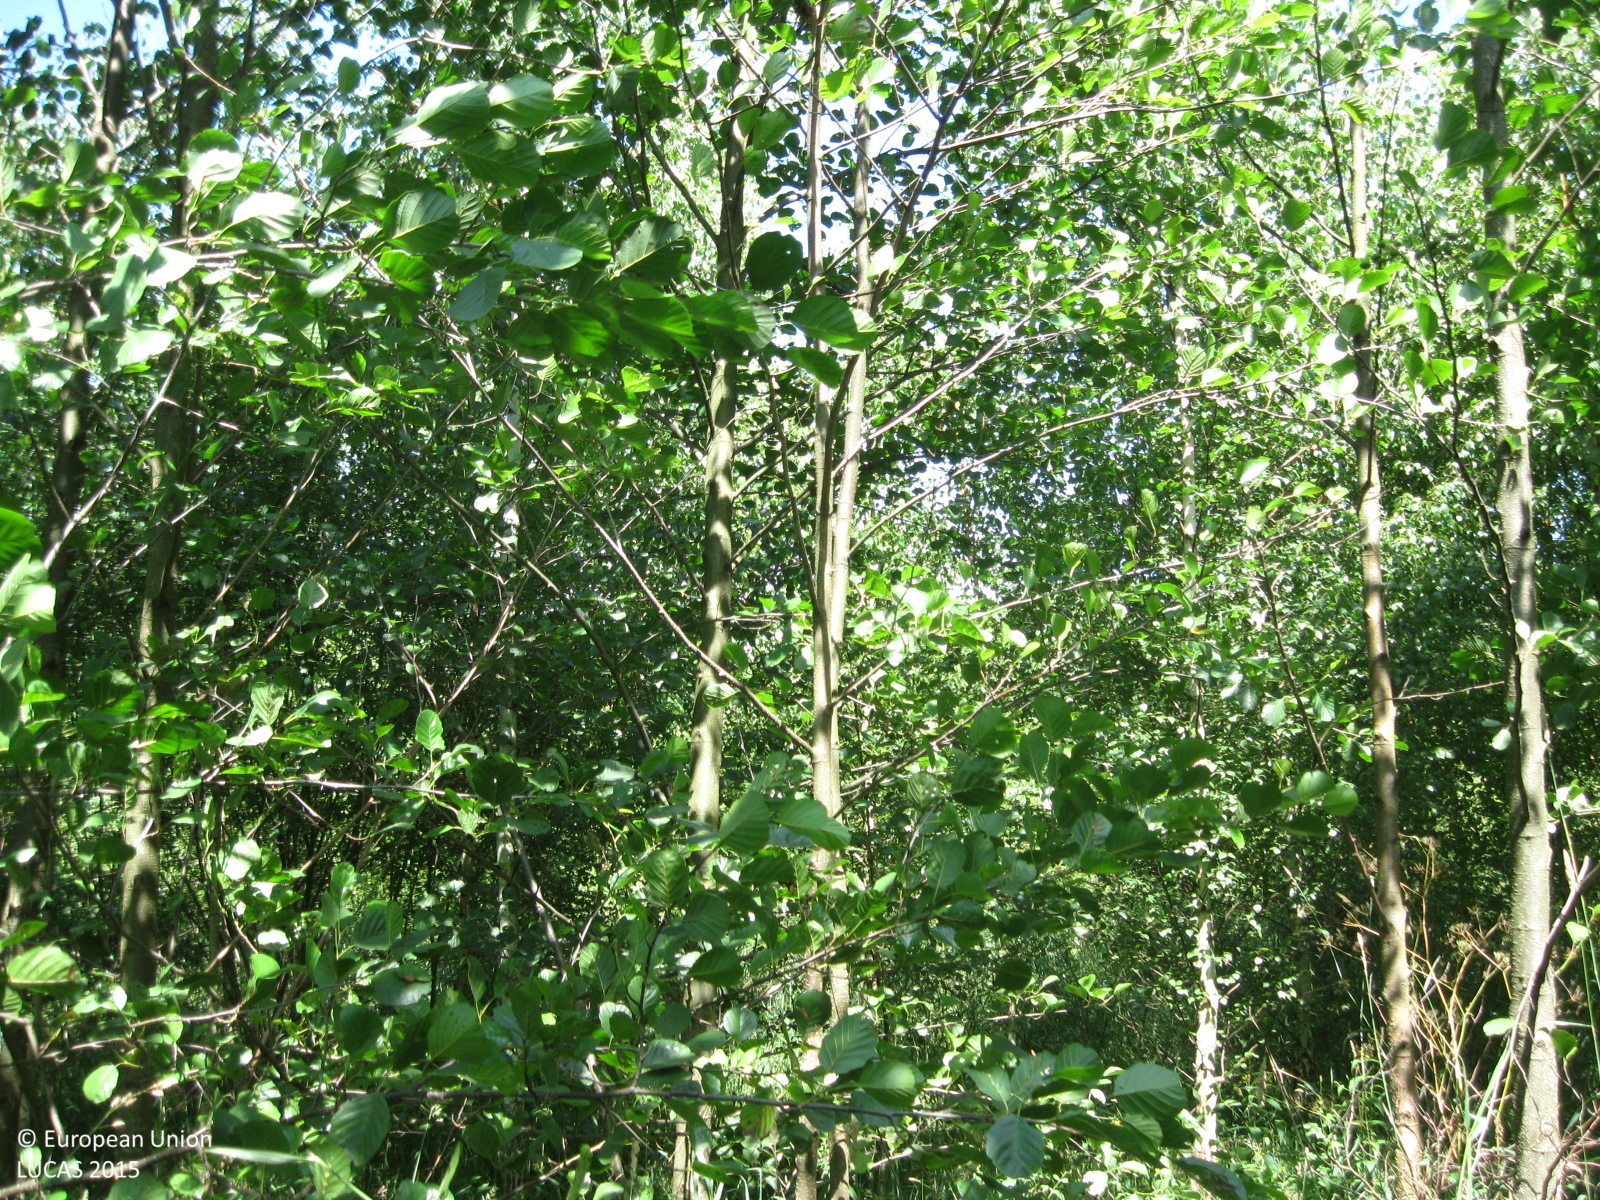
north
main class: Woodland
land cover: Broadleaved woodland
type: non-riverine alder, birch or aspen forest
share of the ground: > 75 %
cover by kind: broadleaved forest trees 75 %, herbaceous plants 25 %
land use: Forestry
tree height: > 5 m
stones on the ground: < 10 %
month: July
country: LT
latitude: 55.1394
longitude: 24.6470
